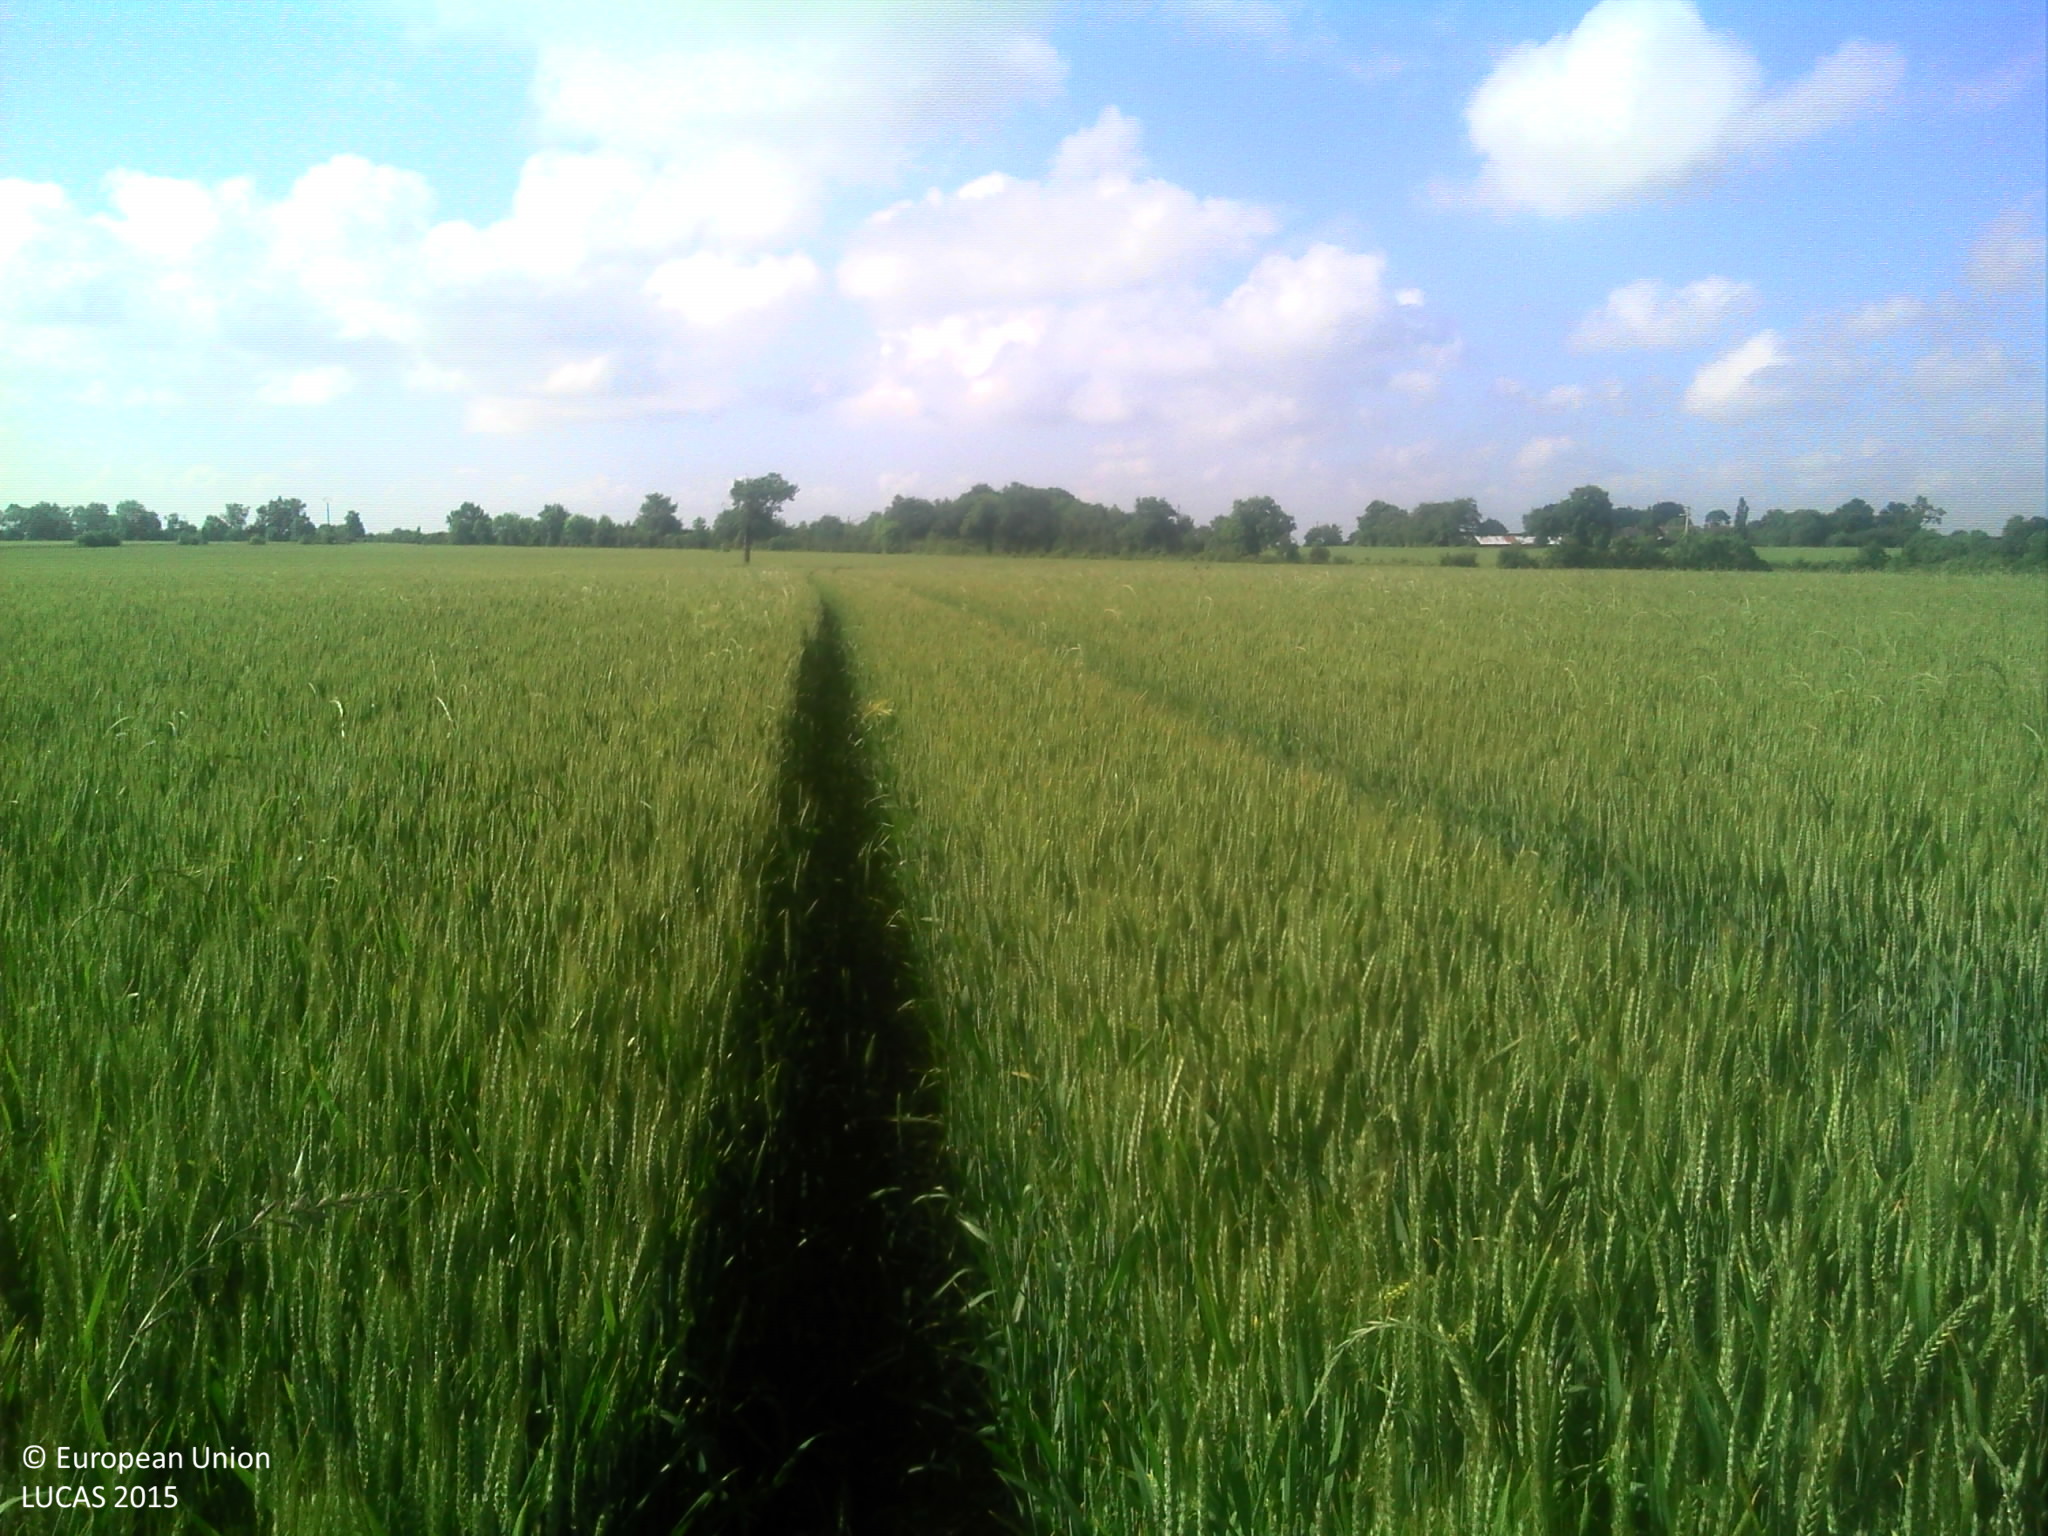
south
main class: Cropland
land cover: Common wheat
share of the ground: > 75 %
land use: Agriculture (excluding fallow land and kitchen gardens)
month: May
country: FR
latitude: 47.4528
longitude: -1.0053
